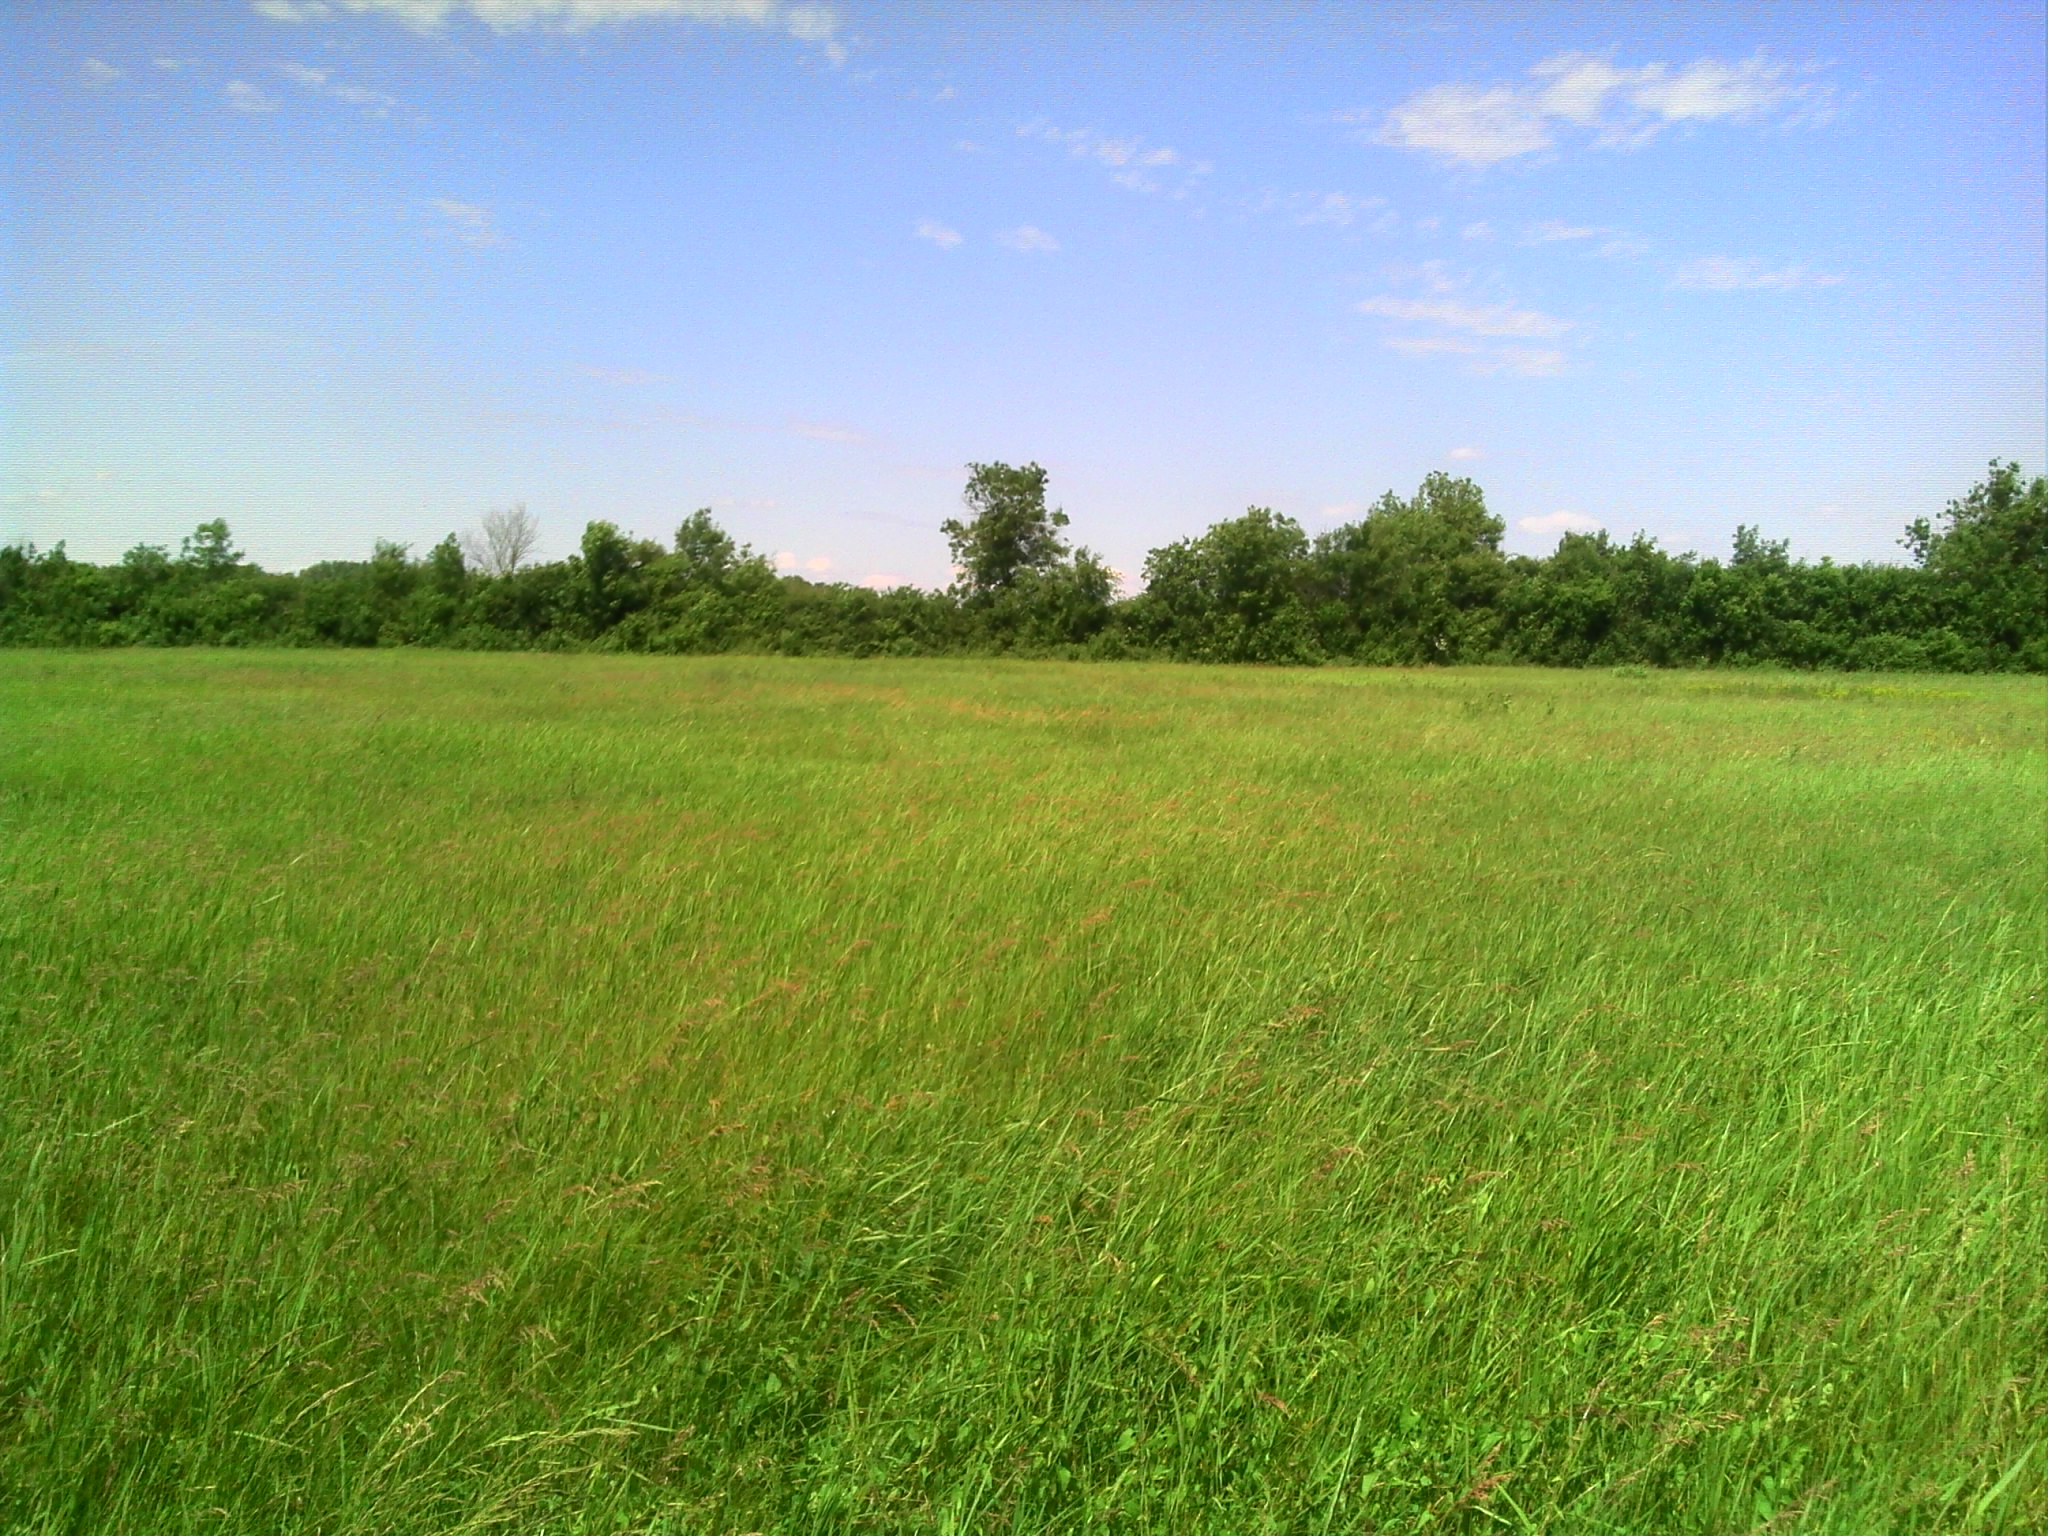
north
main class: Grassland
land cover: Grassland without tree/shrub cover
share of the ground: > 75 %
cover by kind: herbaceous plants 100 %
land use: Agriculture (excluding fallow land and kitchen gardens)
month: May
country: FR
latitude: 46.5737
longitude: 4.9262
